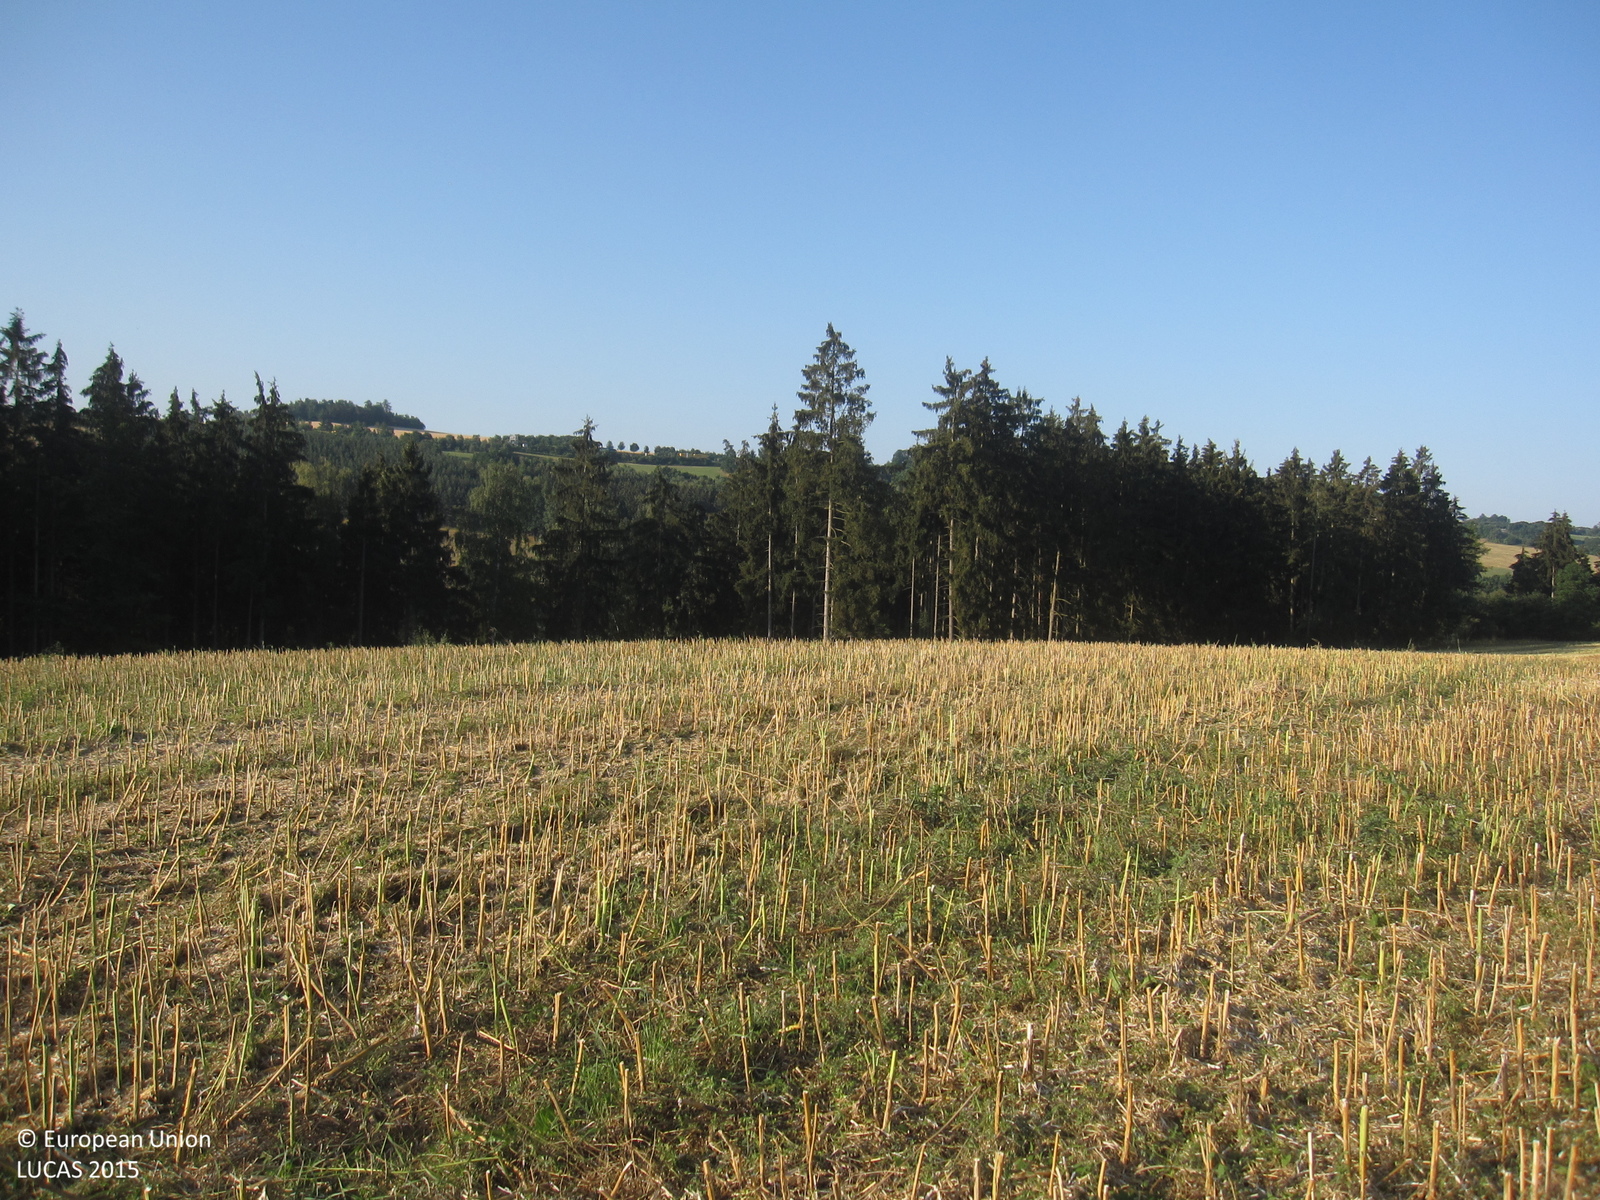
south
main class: Cropland
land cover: Rape and turnip rape
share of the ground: < 10 %
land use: Agriculture (excluding fallow land and kitchen gardens)
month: July
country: DE
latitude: 50.4178
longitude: 12.0403
